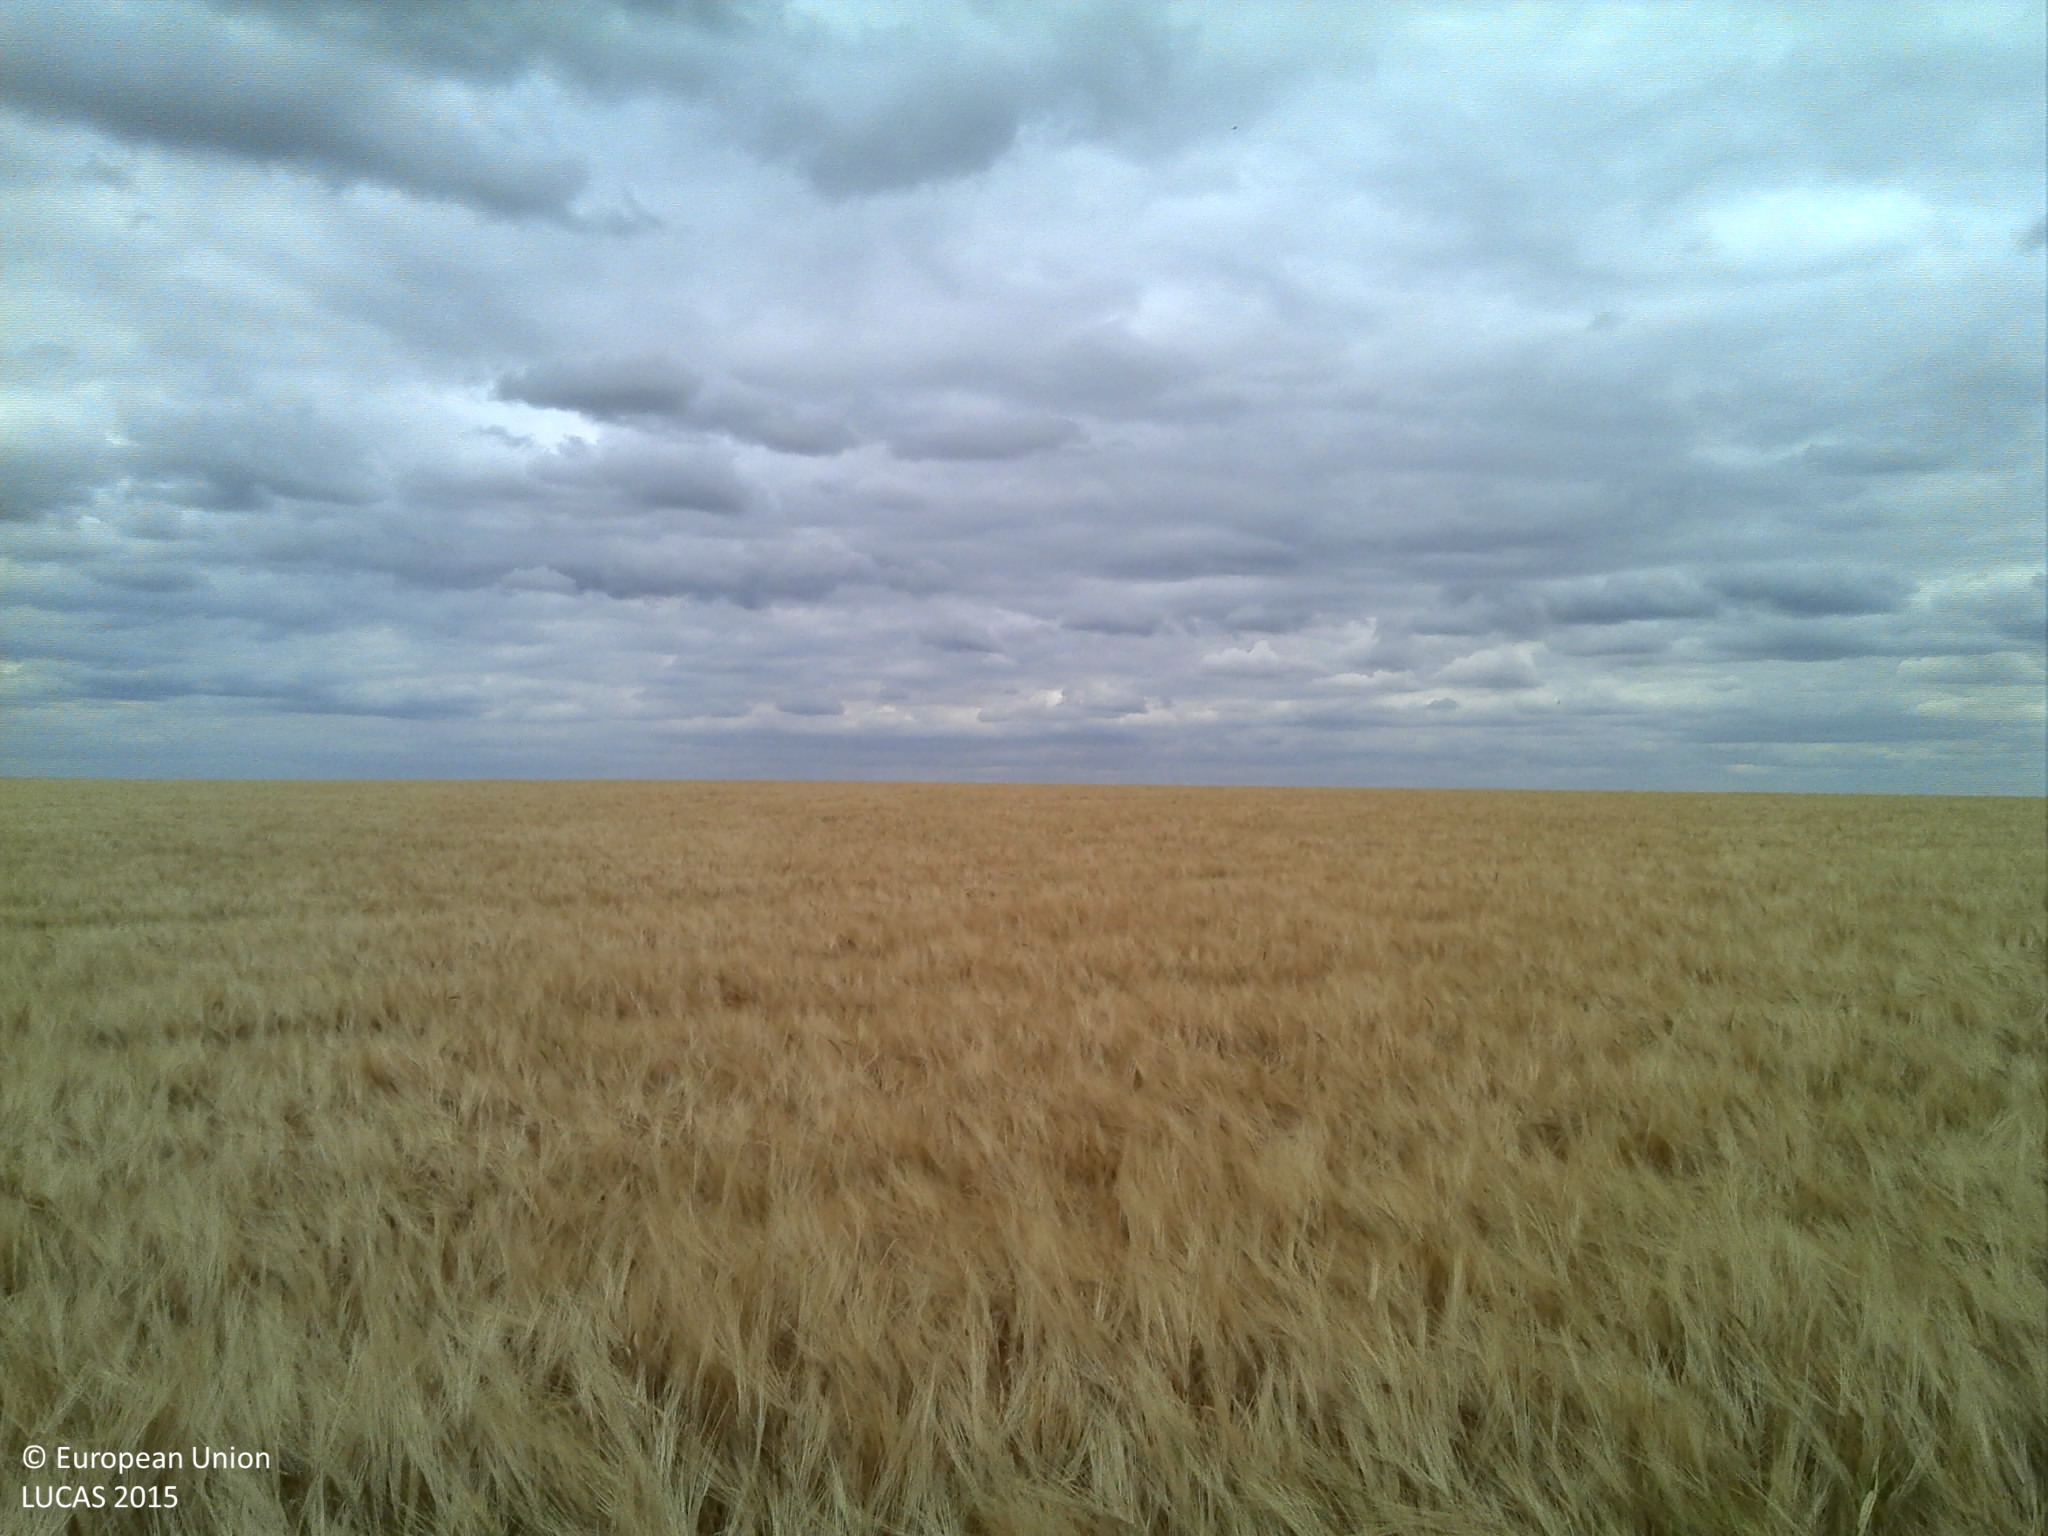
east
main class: Cropland
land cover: Barley
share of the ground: > 75 %
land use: Agriculture (excluding fallow land and kitchen gardens)
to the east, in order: Barley; Grass margins; Sugar beet
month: July
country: FR
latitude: 48.4868
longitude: 2.4256
